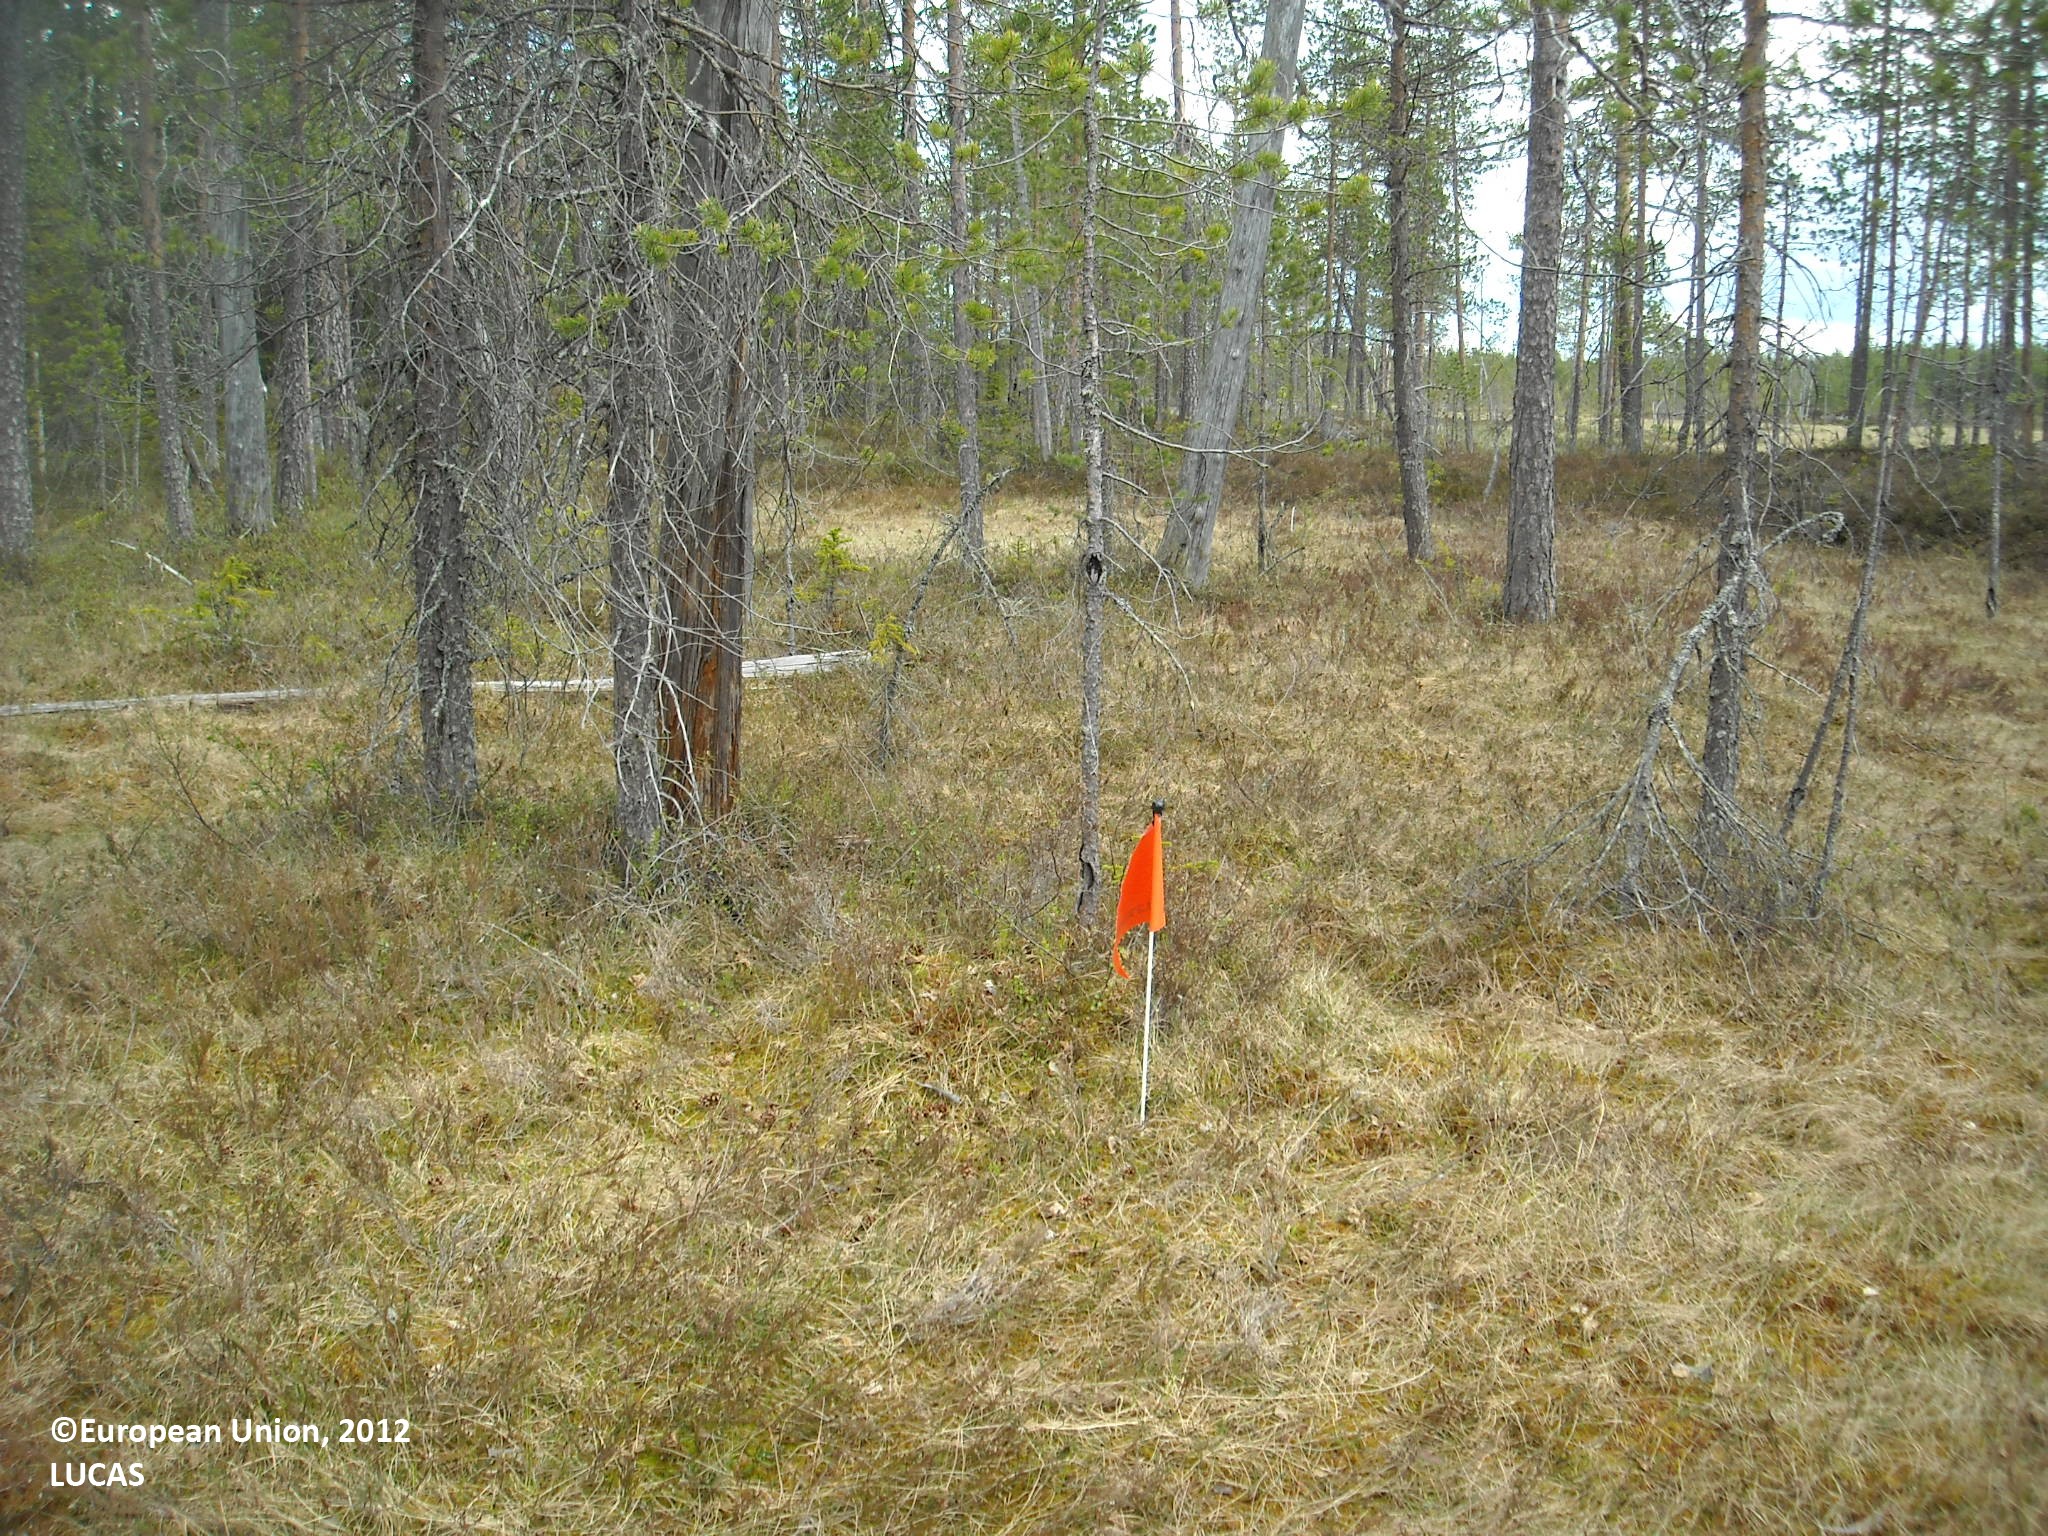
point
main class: Woodland
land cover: Pine dominated coniferous woodland
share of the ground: 25 - 50 %
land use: Semi-natural and natural areas not in use
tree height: > 5 m
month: June
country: FI
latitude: 65.3385
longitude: 27.7741
